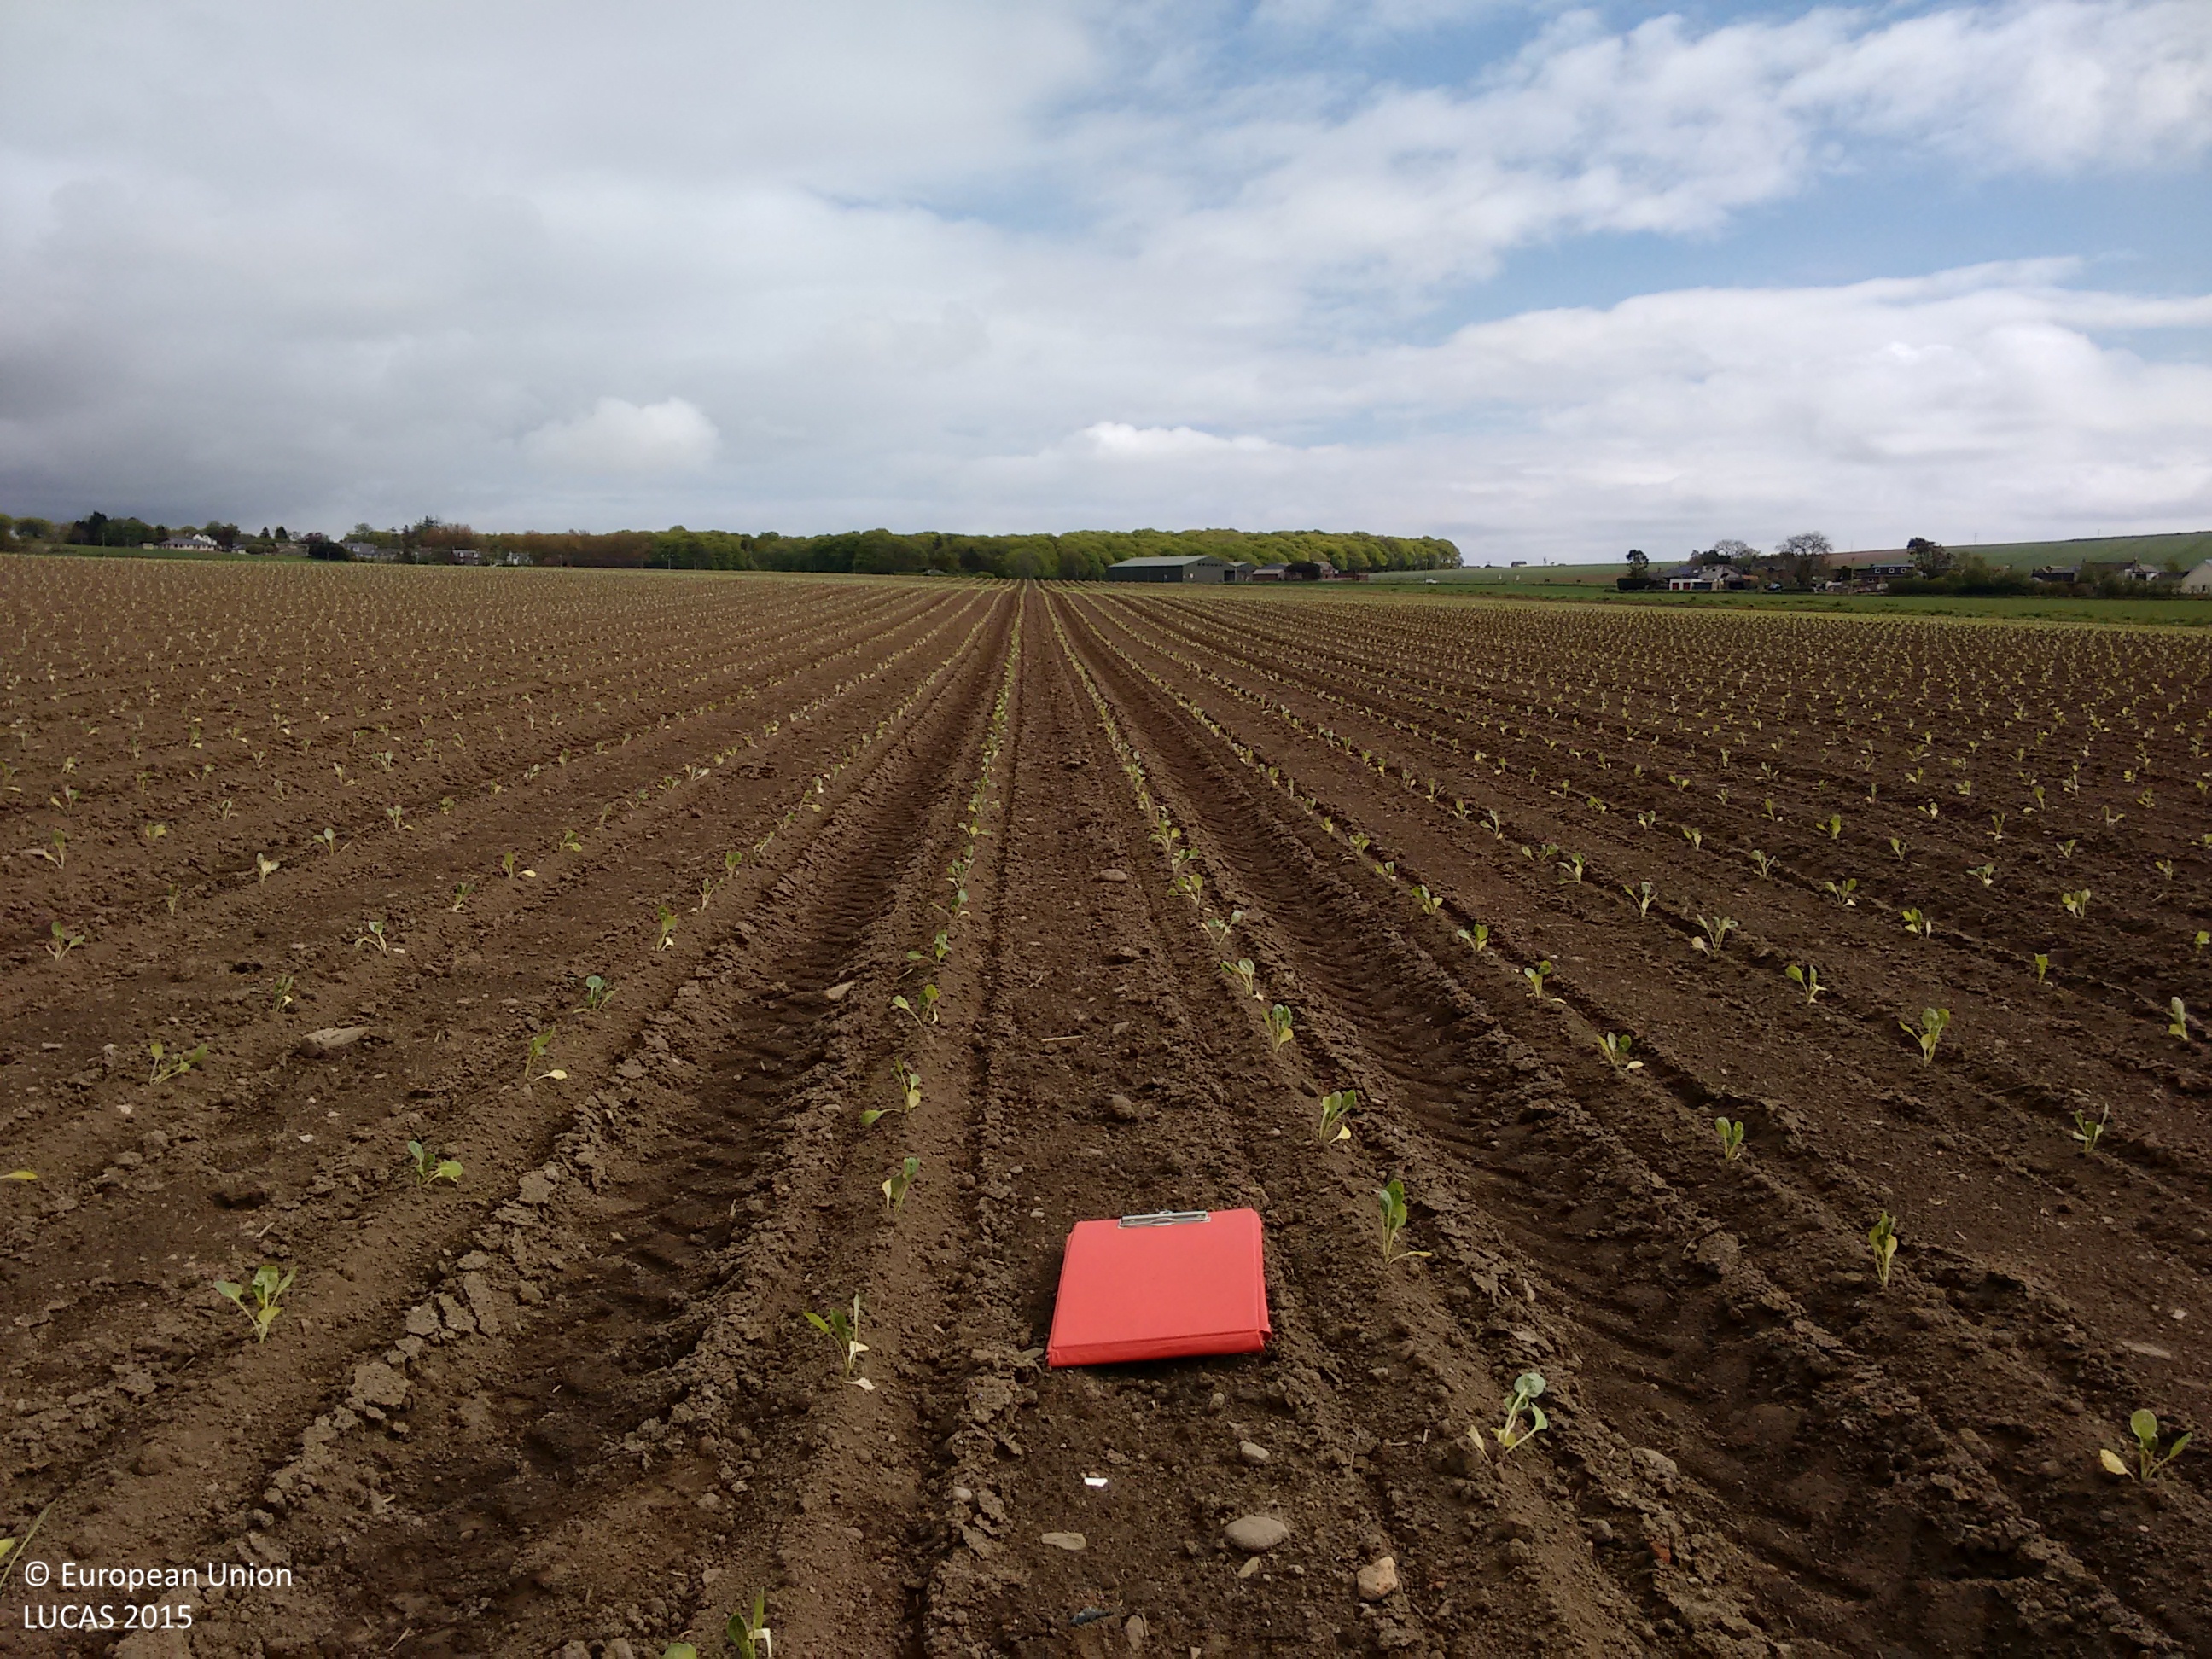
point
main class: Cropland
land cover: Other fresh vegetables
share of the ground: < 10 %
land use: Agriculture (excluding fallow land and kitchen gardens)
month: May
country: GB
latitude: 56.5862
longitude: -2.5793
